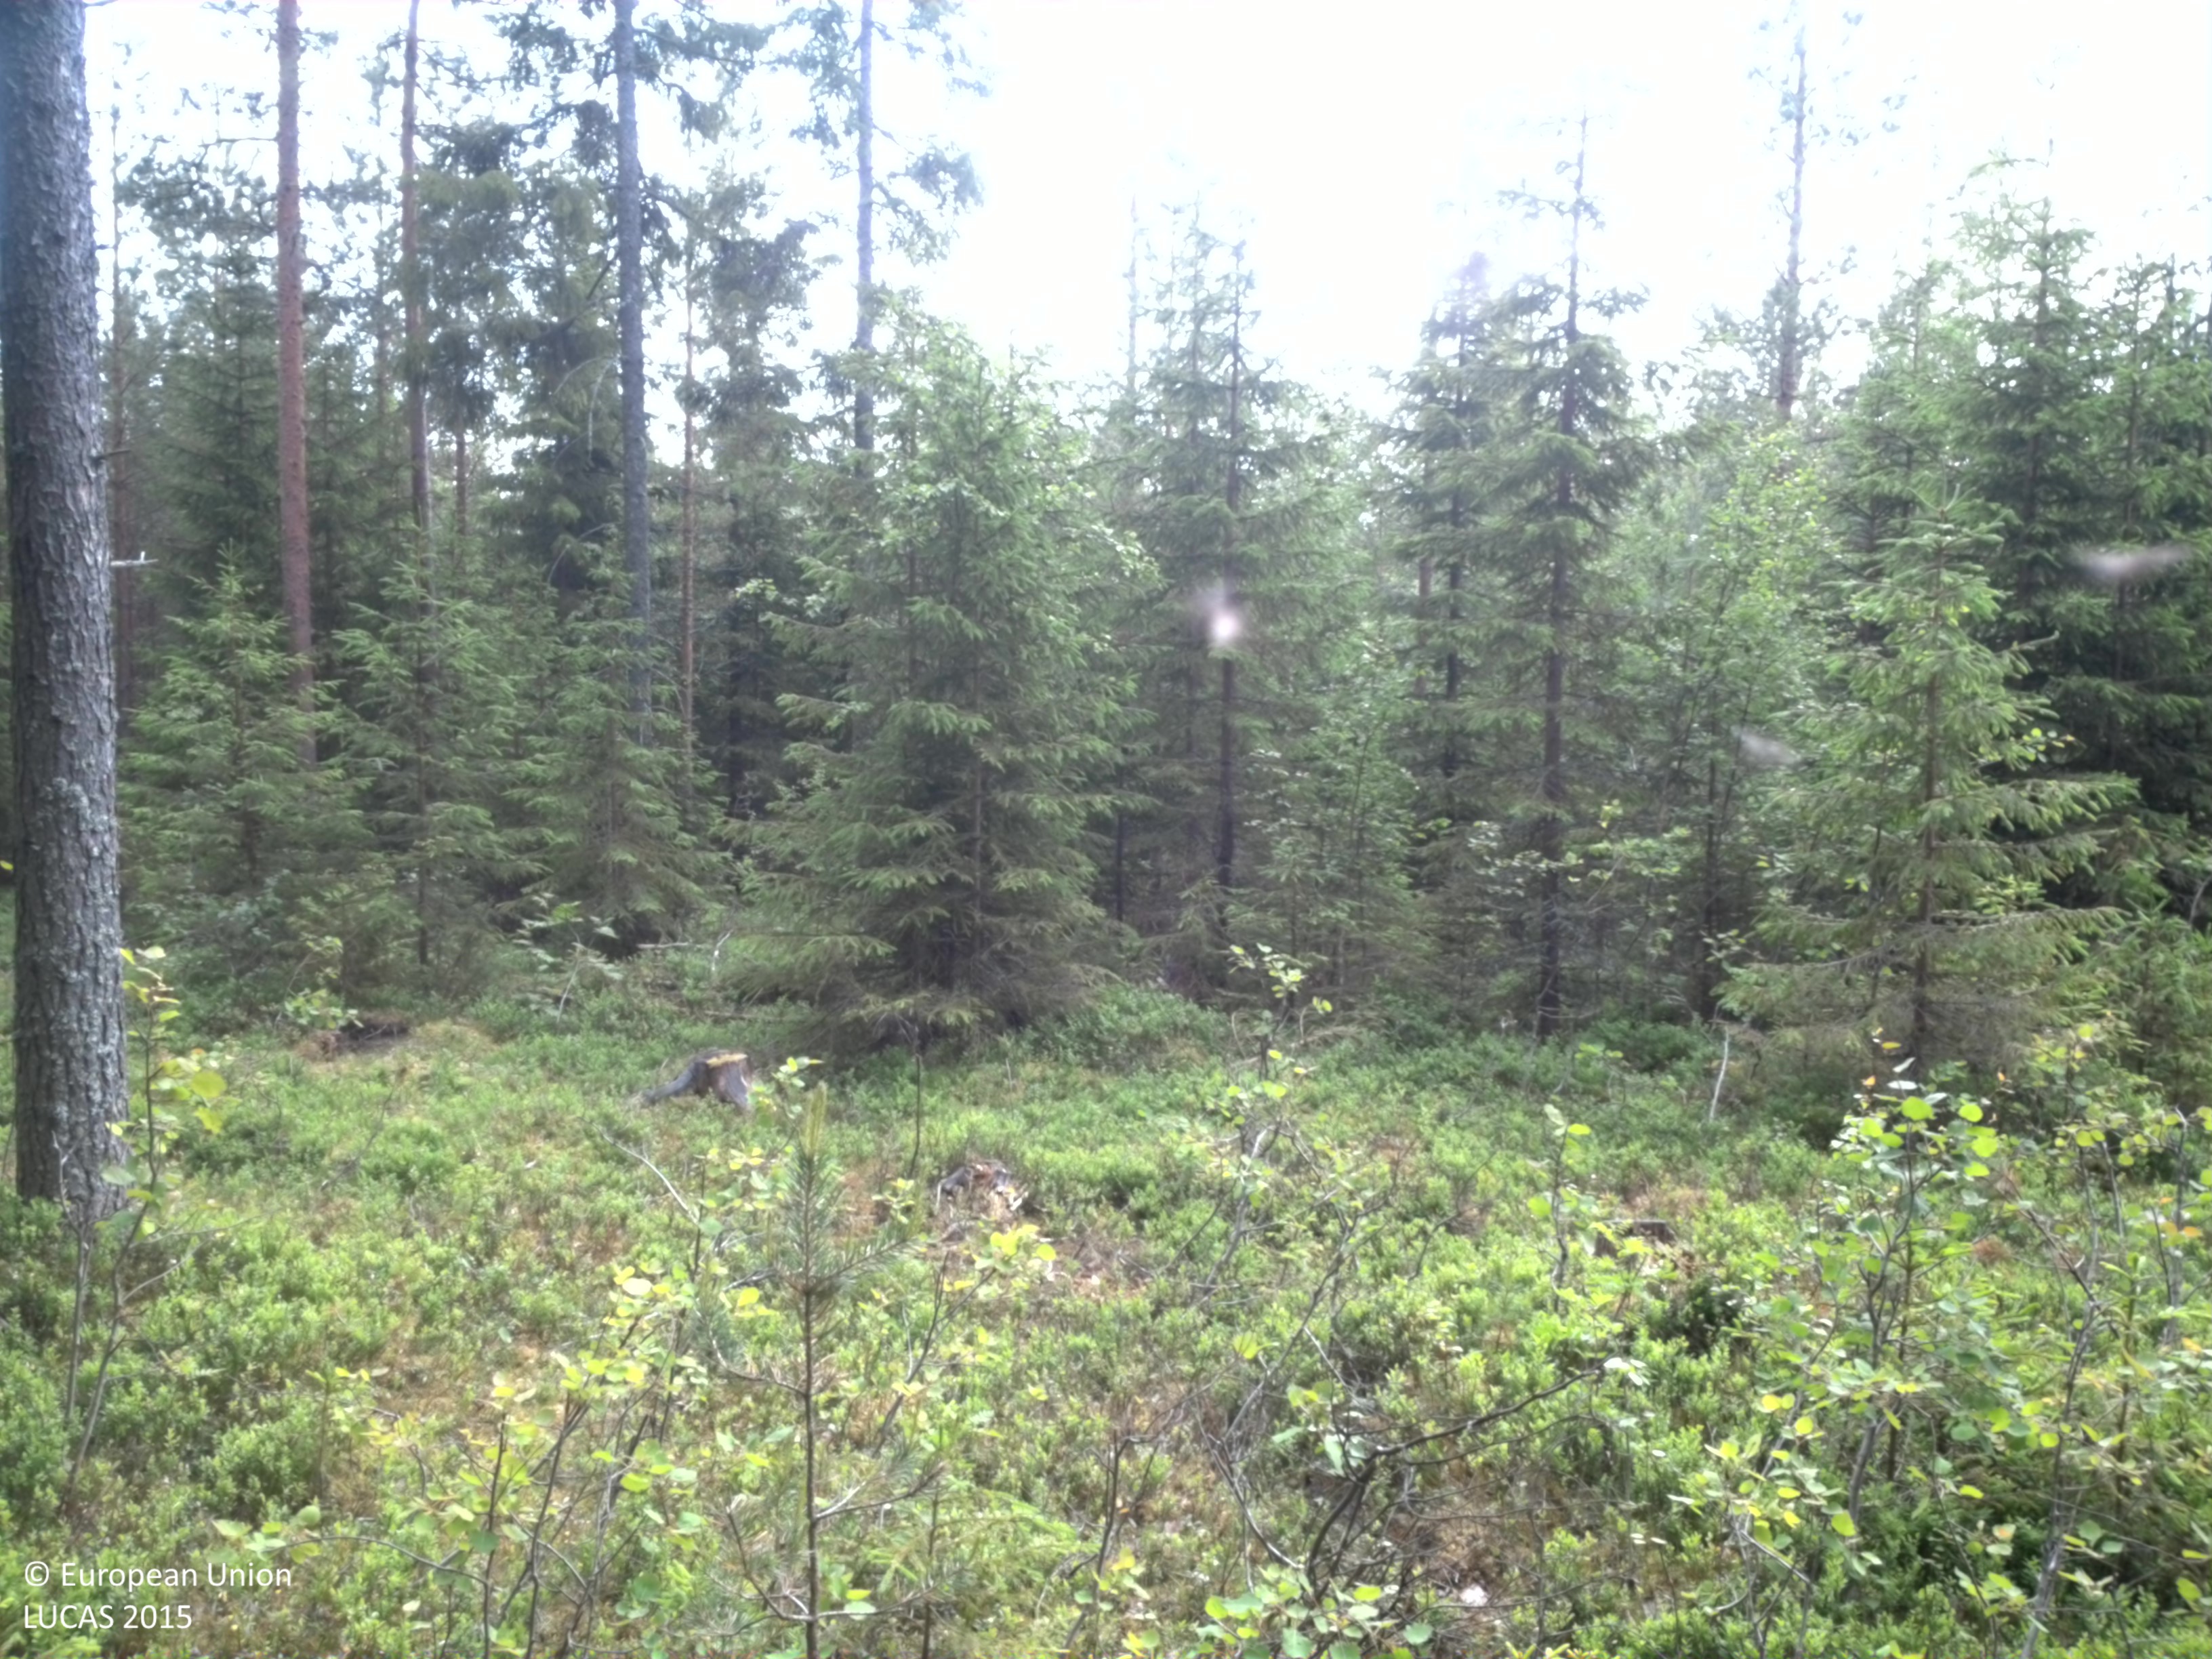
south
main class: Woodland
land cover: Other mixed woodland
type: boreal forest
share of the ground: > 75 %
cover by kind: coniferous forest trees 60 %, broadleaved forest trees 20 %, shrubs 20 %
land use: Forestry
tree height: > 5 m
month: July
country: SE
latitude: 64.4072
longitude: 20.8736
